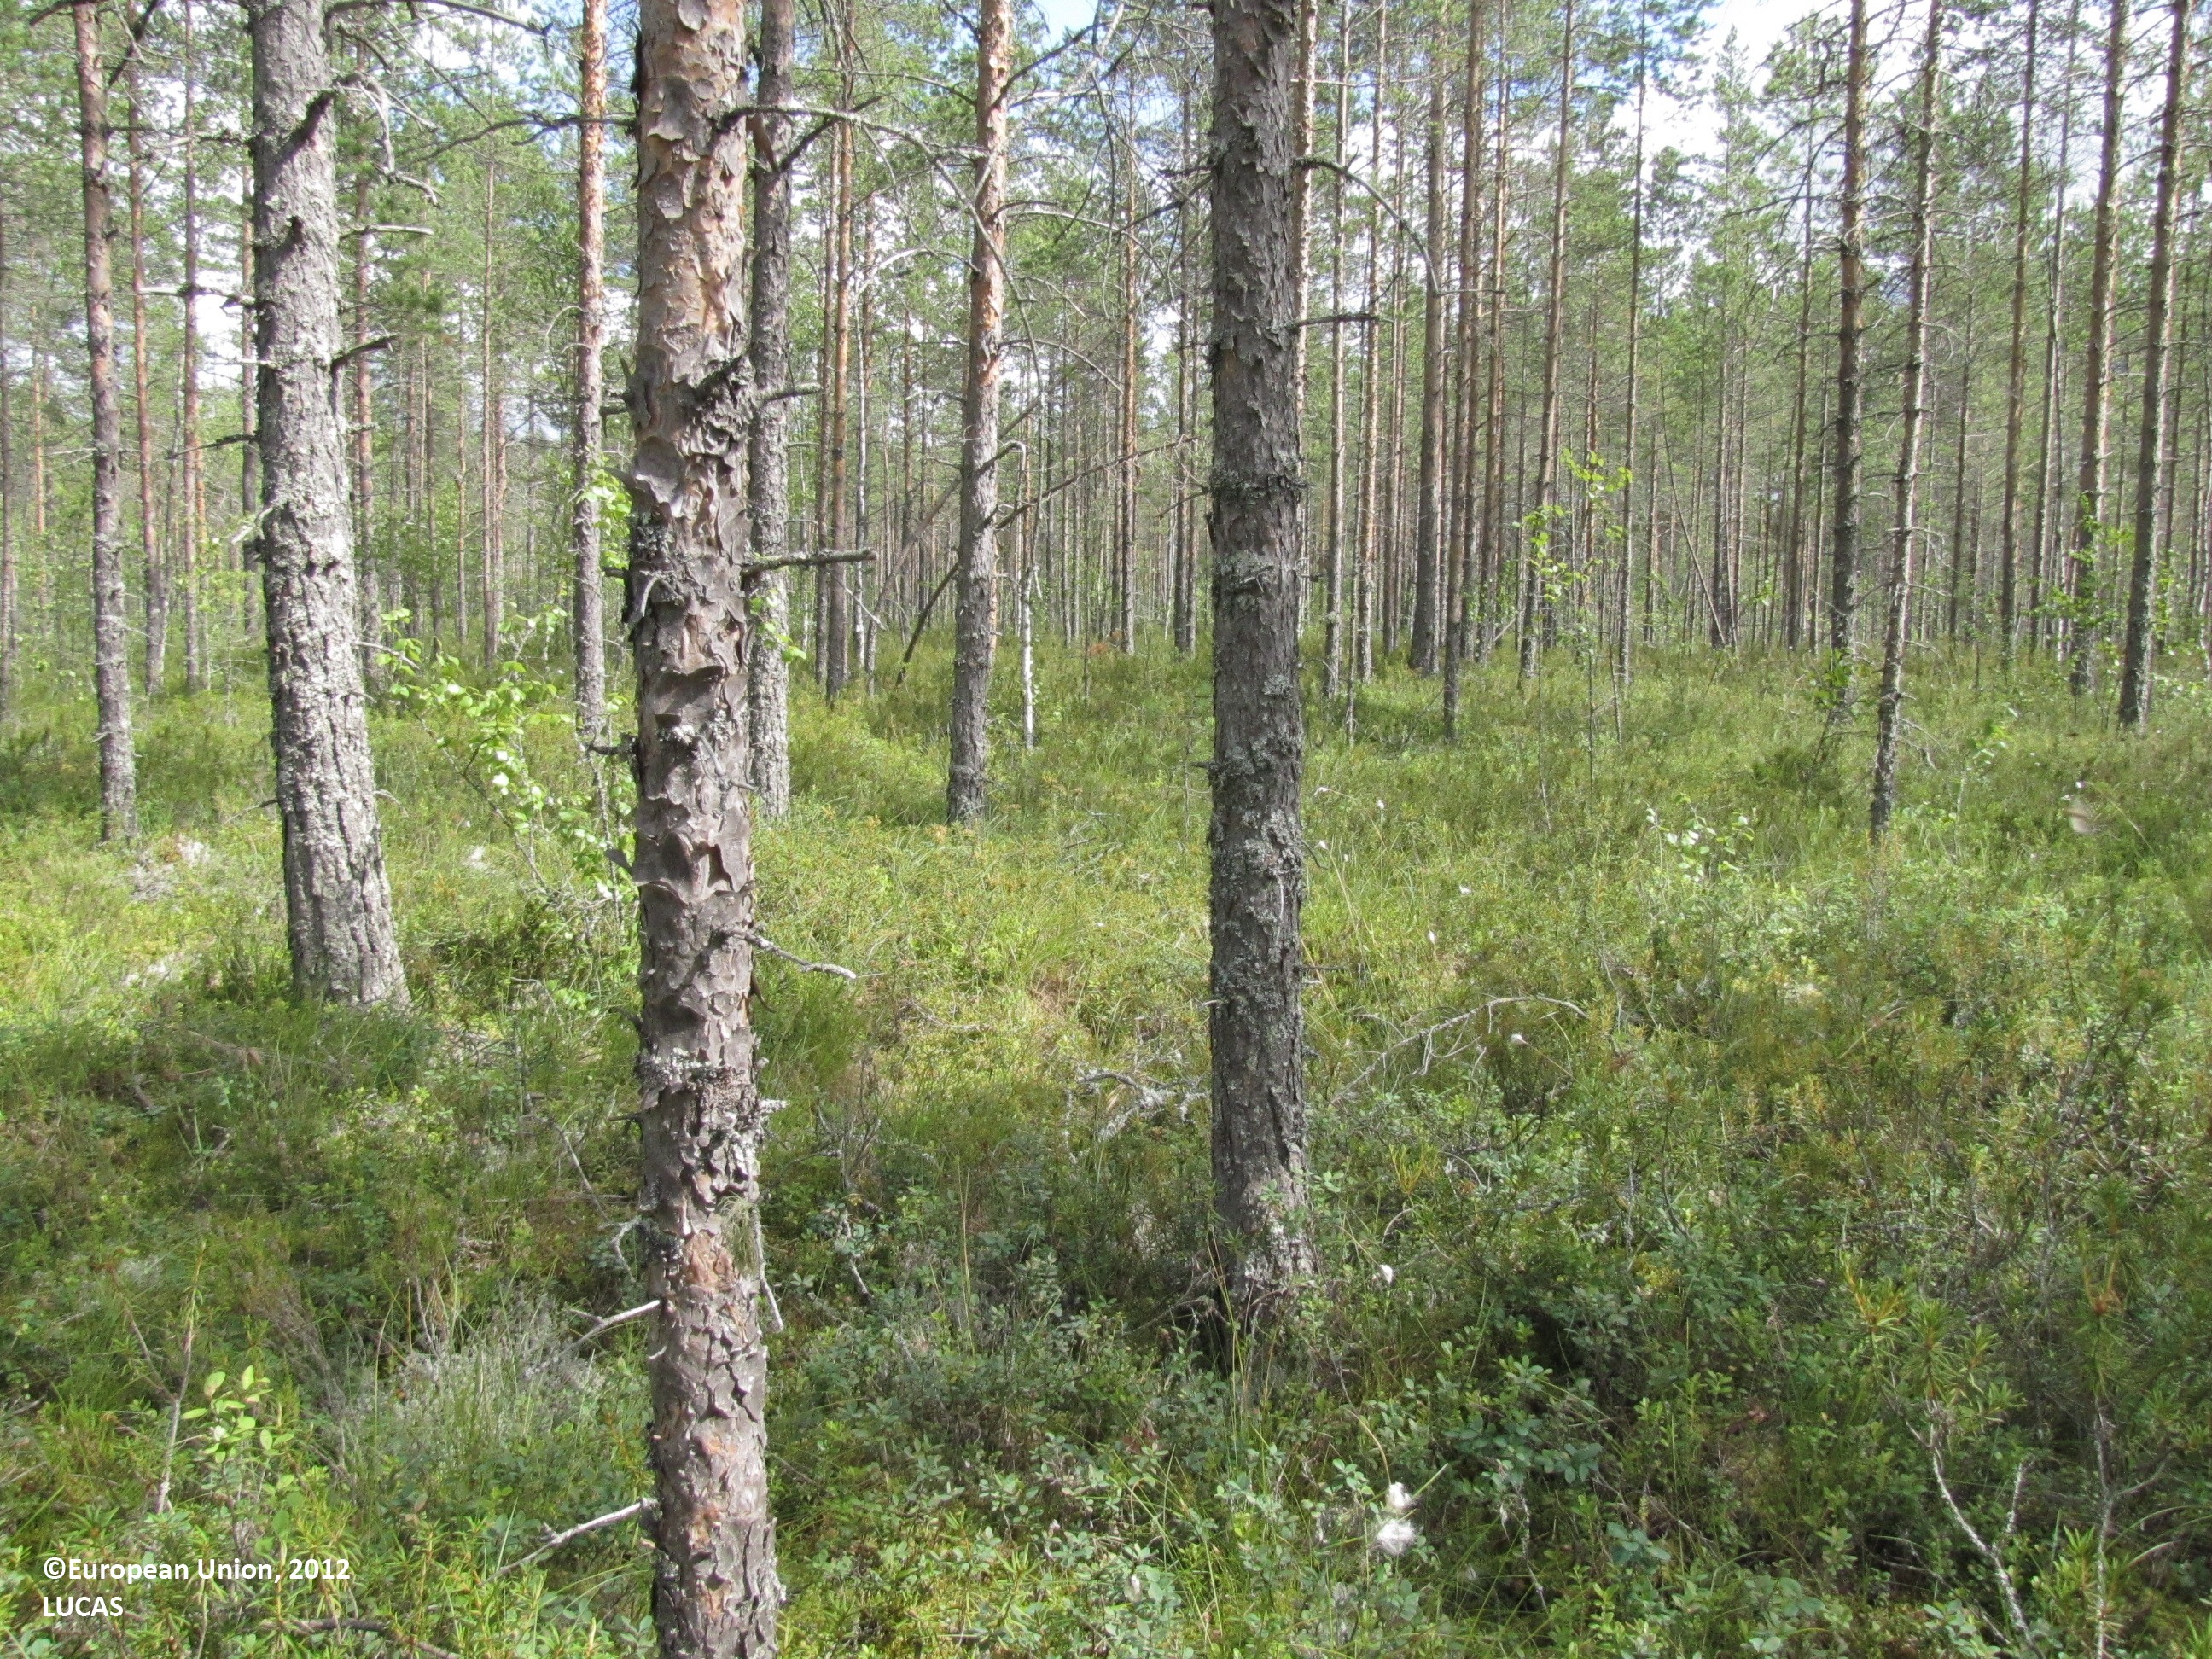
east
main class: Woodland
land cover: Pine dominated coniferous woodland
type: boreal forest
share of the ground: 50 - 75 %
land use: Forestry
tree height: > 5 m
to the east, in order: Pine dominated coniferous woodland; Ditches and canals; Pine dominated coniferous woodland; Ditches and canals; Pine dominated coniferous woodland; Ditches and canals; Abandoned hedges; Shrubland with sparse tree cover; Abandoned hedges; Ditches and canals; Abandoned hedges; Shrubland with sparse tree cover; Abandoned hedges; Ditches and canals; Abandoned hedges; Shrubland with sparse tree cover; Ditches and canals; Abandoned hedges; Pine dominated coniferous woodland
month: July
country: FI
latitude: 62.6306
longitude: 23.2265
